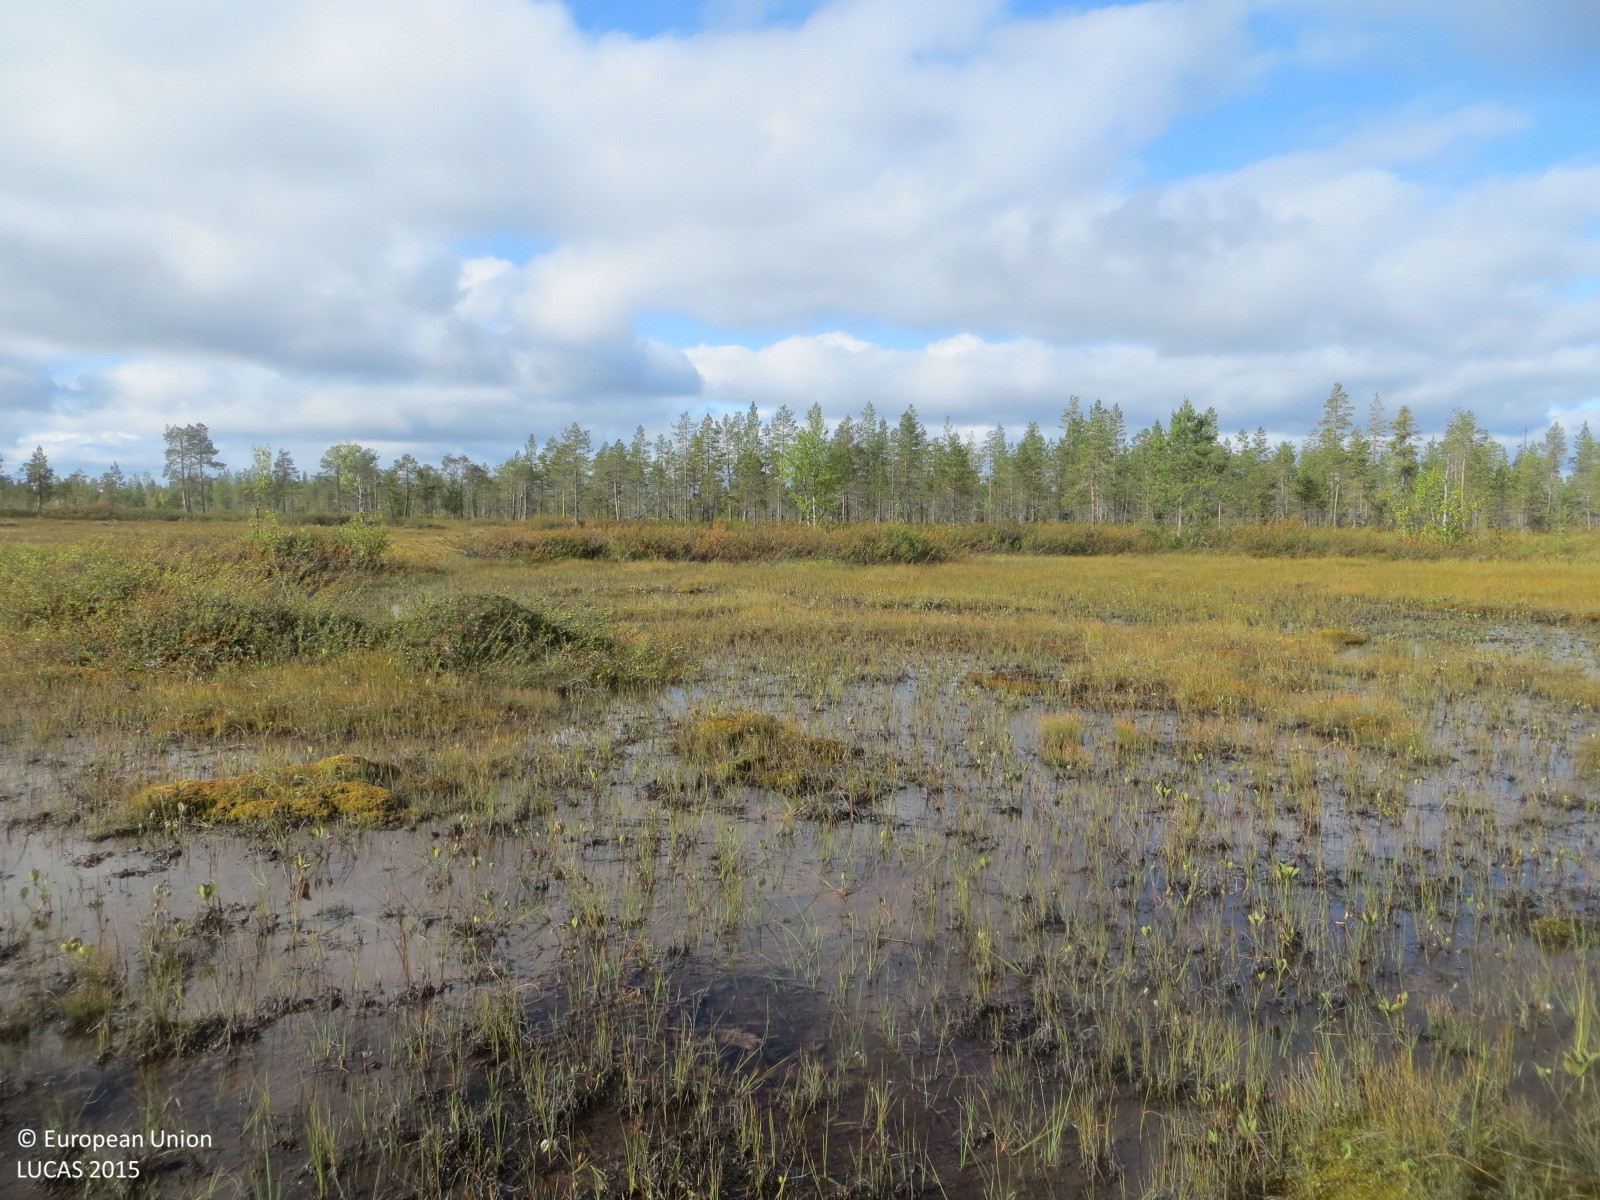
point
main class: Woodland
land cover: Pine dominated coniferous woodland
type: mire and swamp forests
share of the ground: 50 - 75 %
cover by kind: coniferous forest trees 50 %, shrubs 50 %
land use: Semi-natural and natural areas not in use
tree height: > 5 m
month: September
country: FI
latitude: 68.1527
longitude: 24.8355
